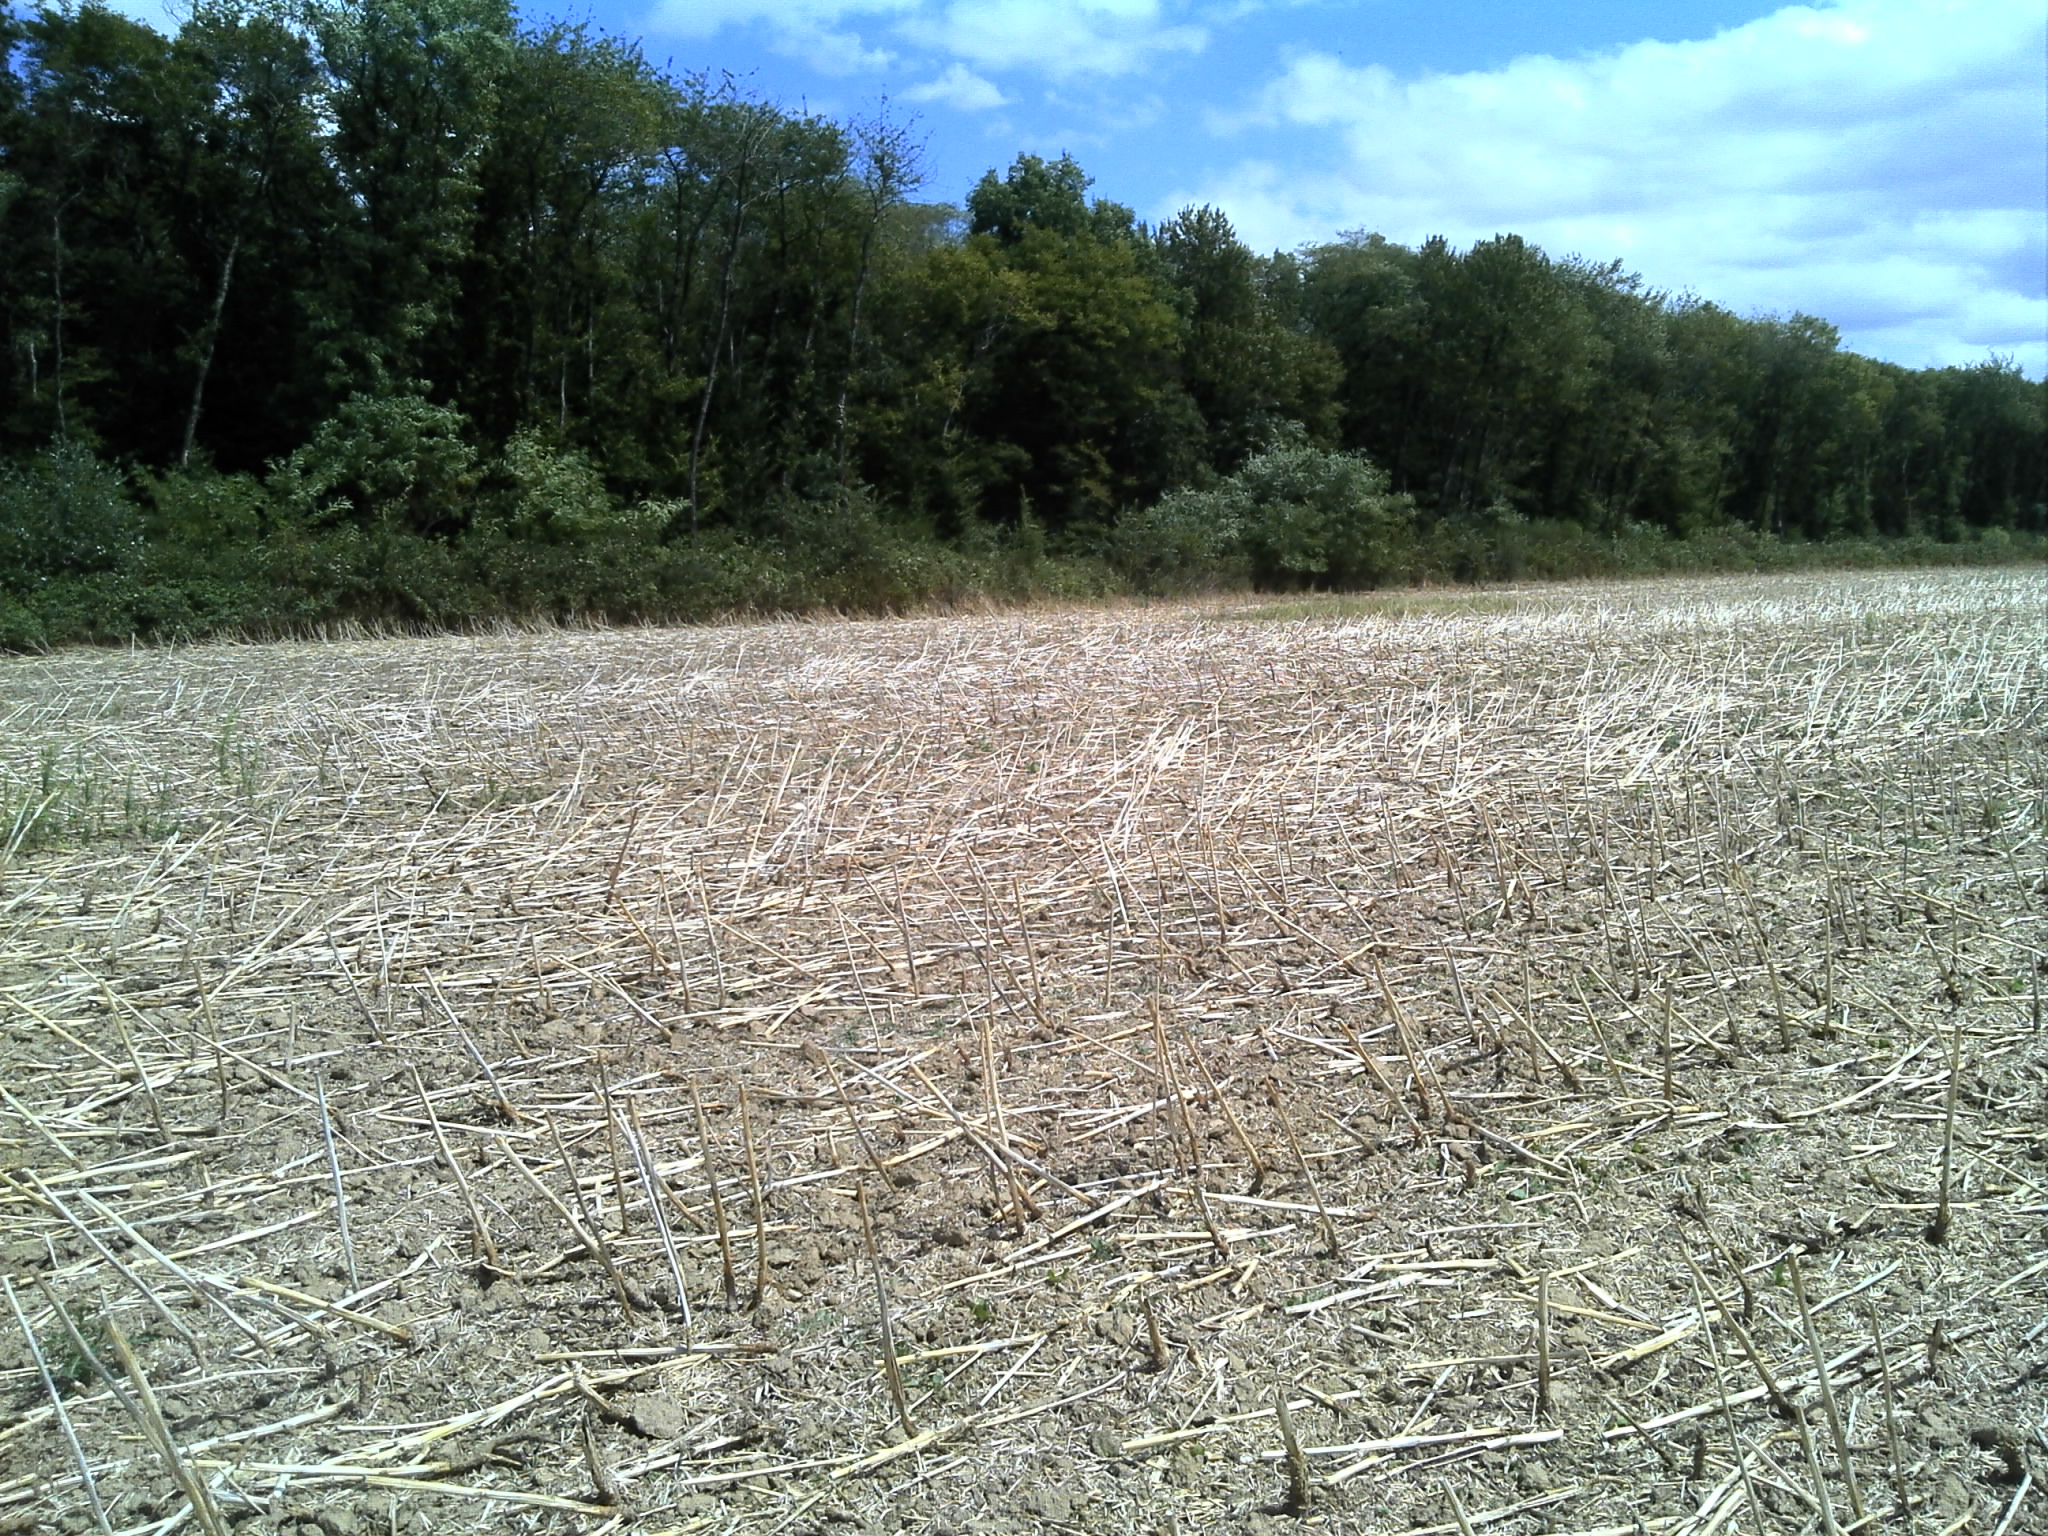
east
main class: Cropland
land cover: Rape and turnip rape
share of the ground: < 10 %
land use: Agriculture (excluding fallow land and kitchen gardens)
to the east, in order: Rape and turnip rape; Broadleaved woodland; Grass margins; Tracks; Broadleaved woodland
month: August
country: FR
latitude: 46.8557
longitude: 1.6344
